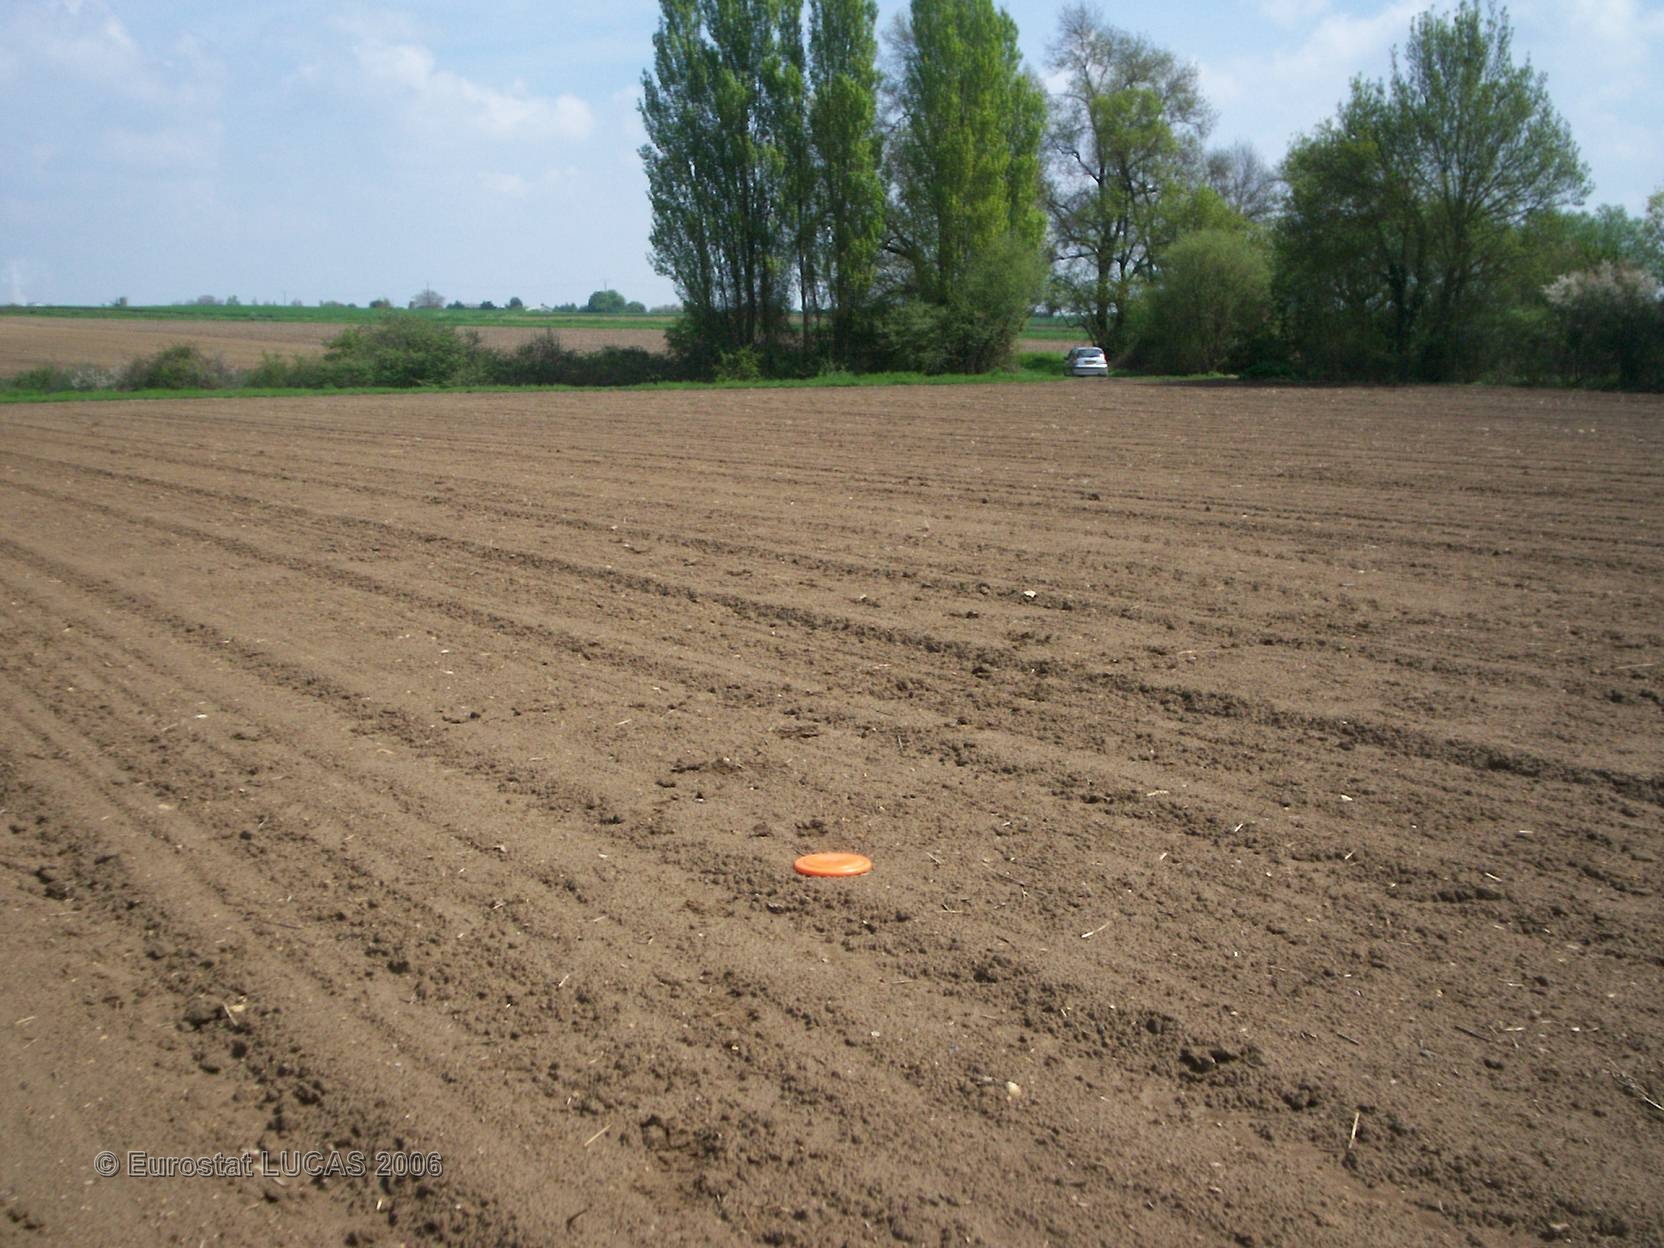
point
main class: Cropland
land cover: Sunflower
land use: Agriculture (excluding fallow land and kitchen gardens)
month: April
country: FR
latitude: 47.2608
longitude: -0.3764
